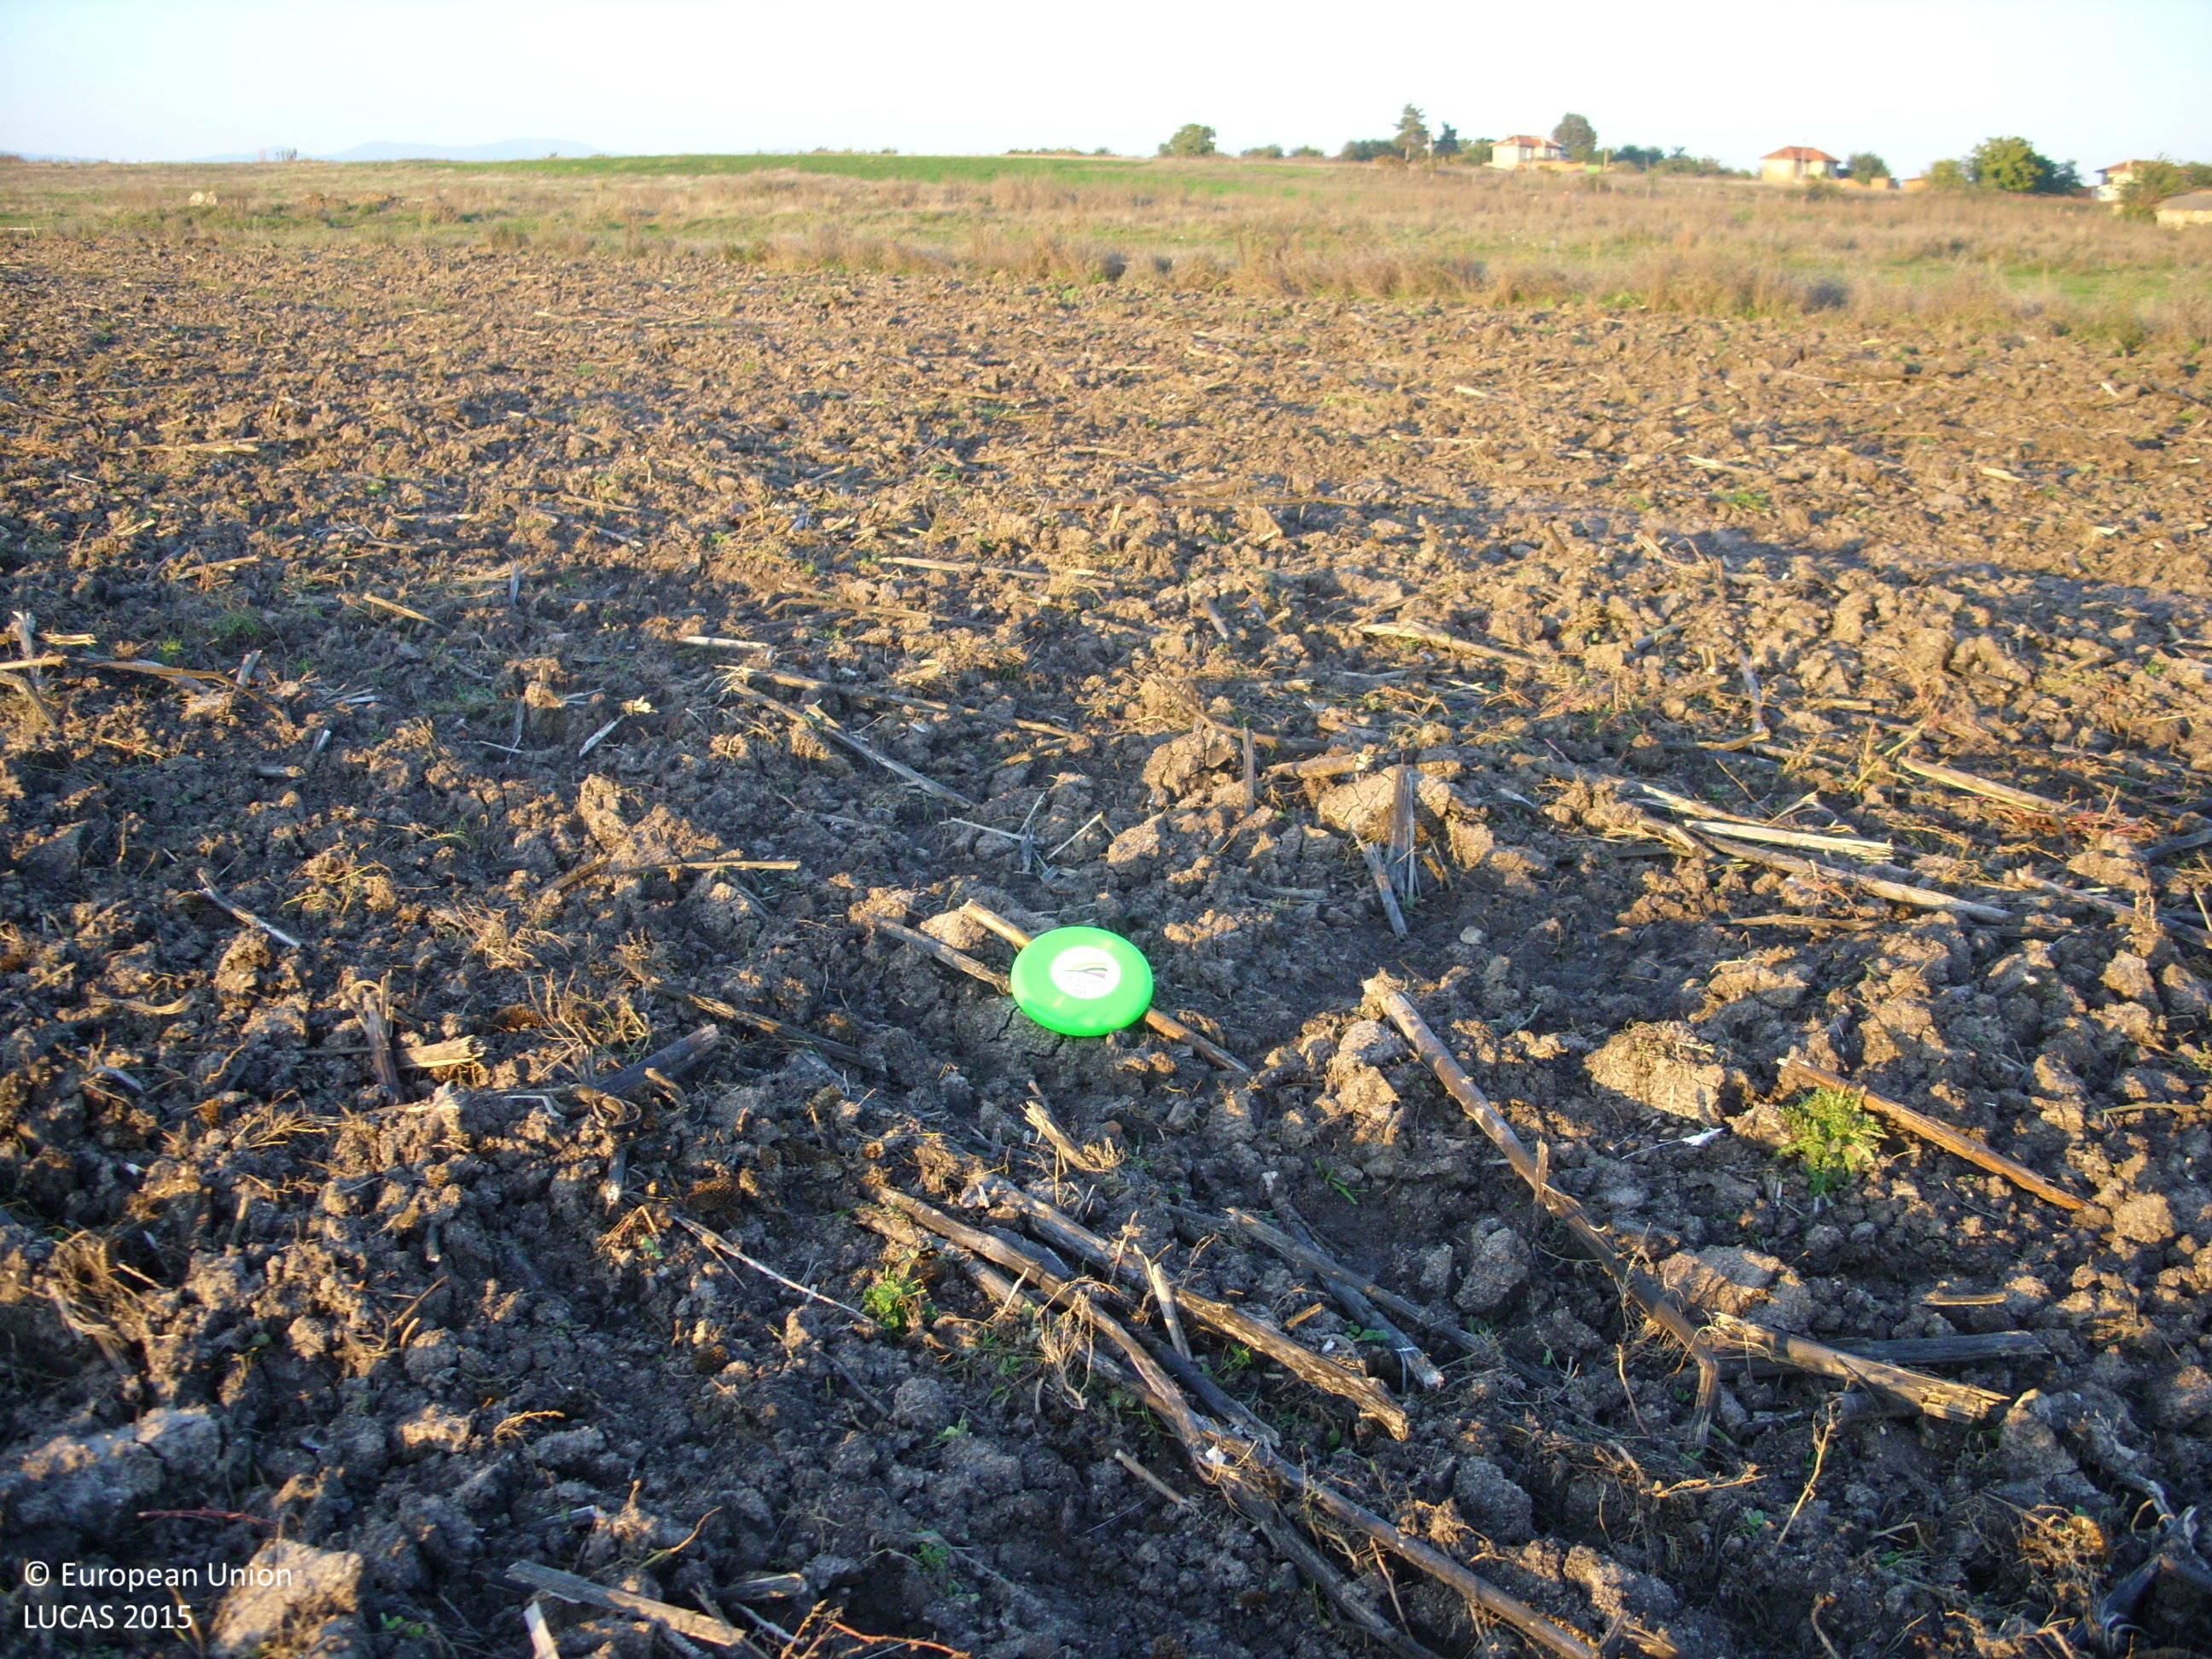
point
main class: Cropland
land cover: Sunflower
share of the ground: < 10 %
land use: Agriculture (excluding fallow land and kitchen gardens)
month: October
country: BG
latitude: 42.3046
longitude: 25.0897
